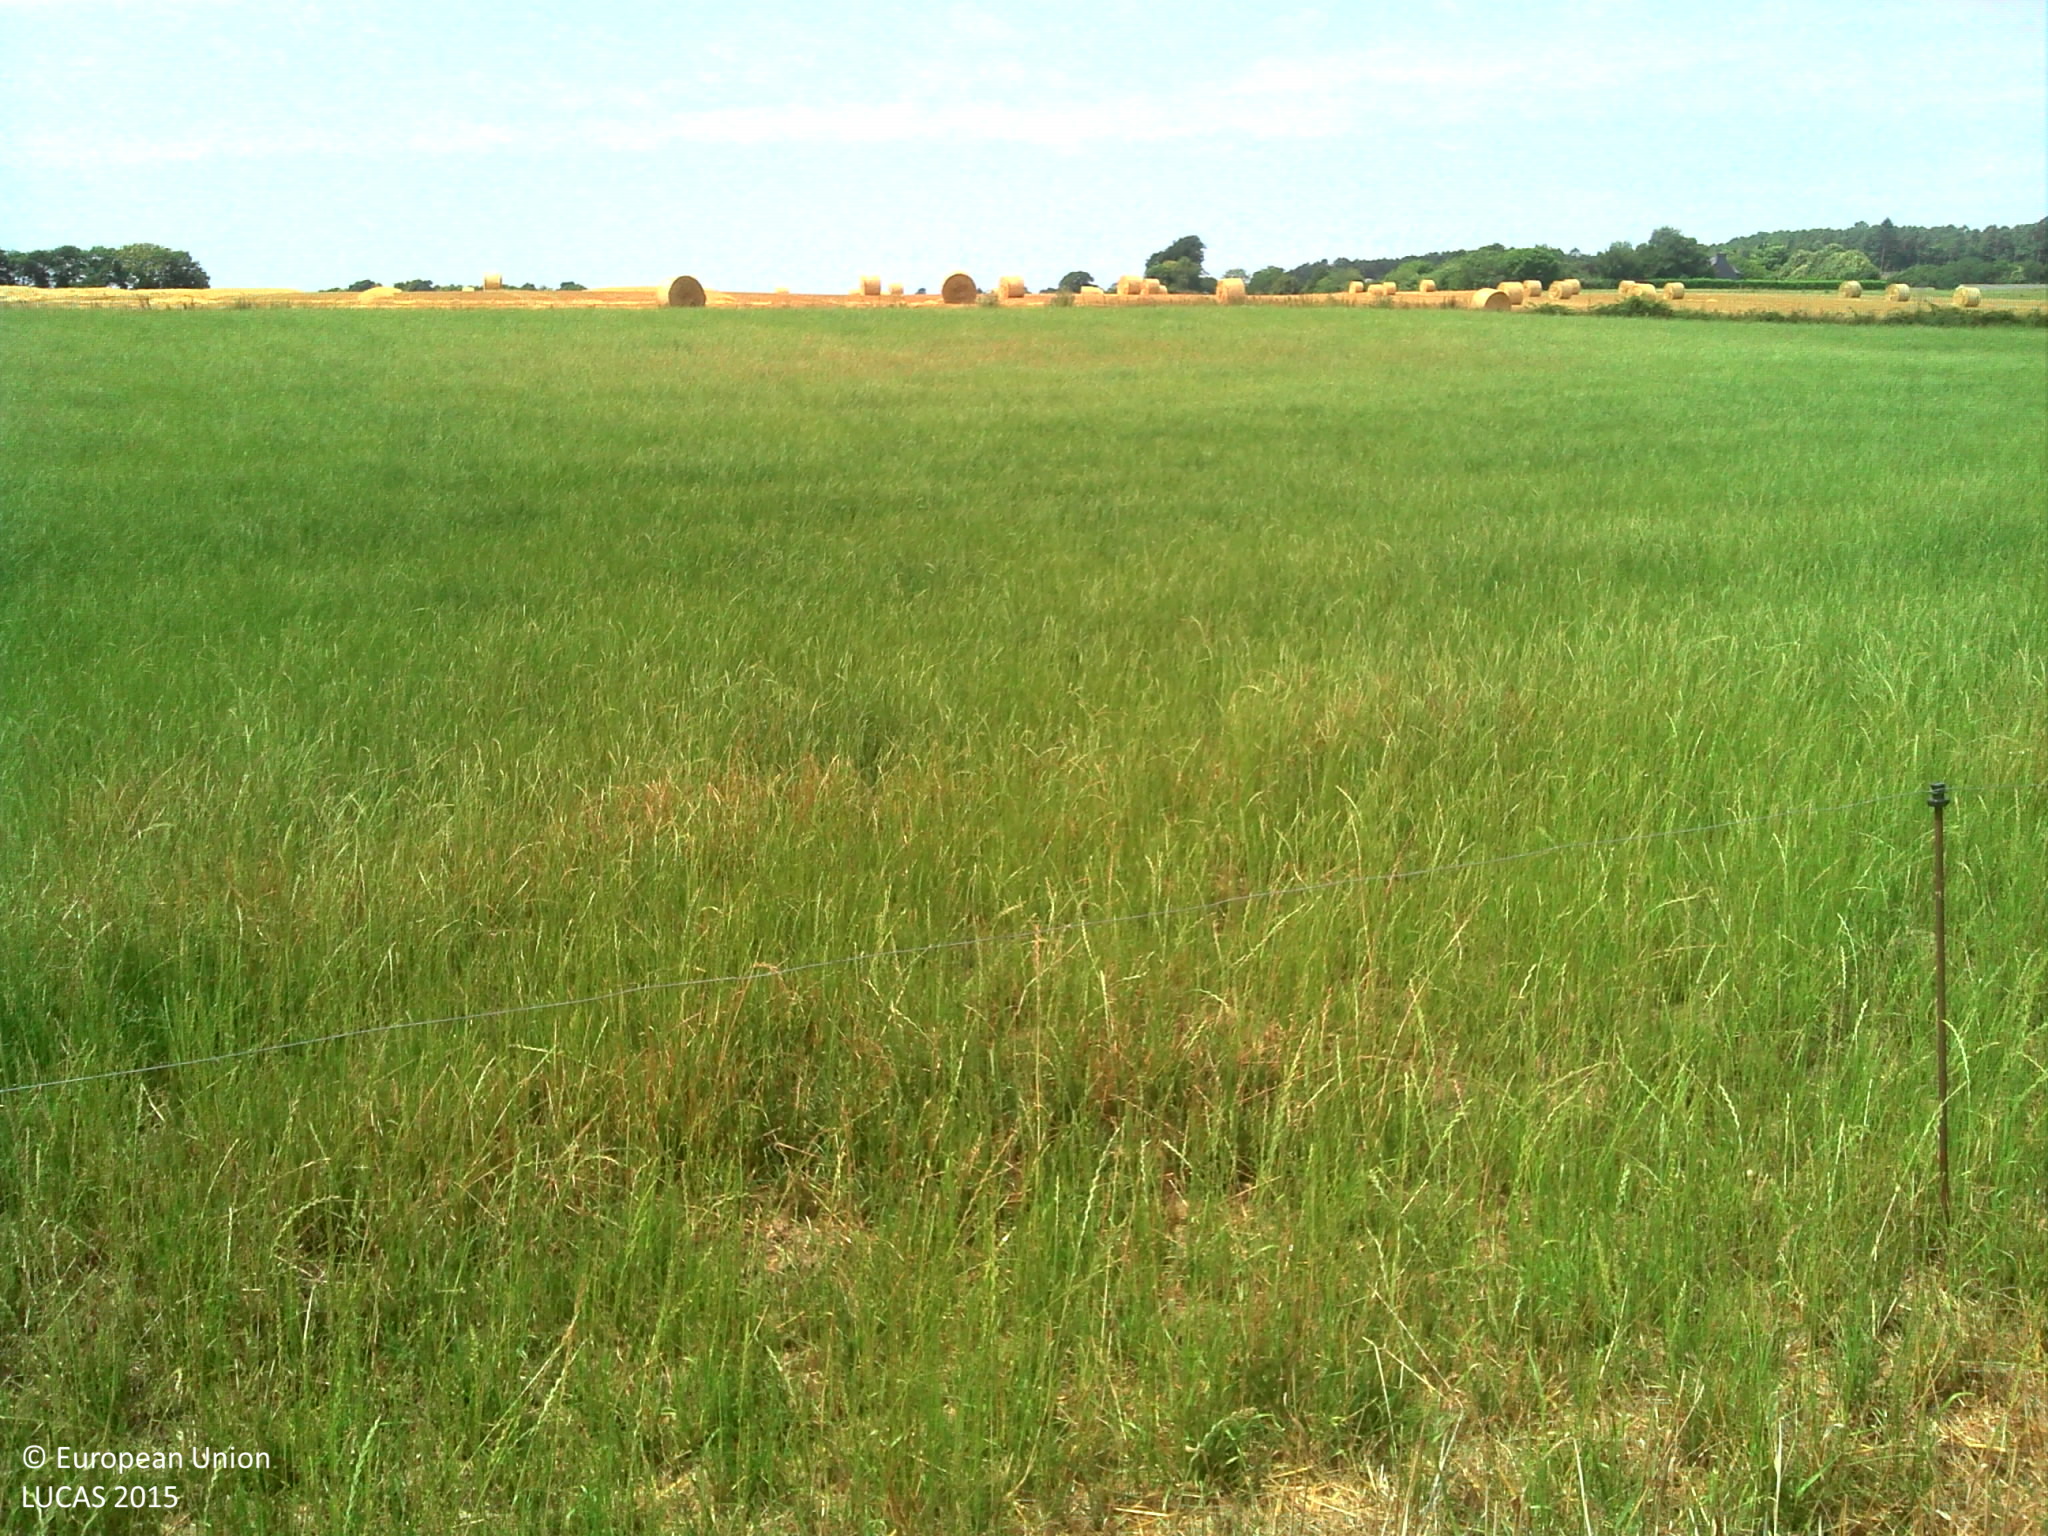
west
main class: Cropland
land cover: Barley
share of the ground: > 75 %
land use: Agriculture (excluding fallow land and kitchen gardens)
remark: Harvested field
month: July
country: FR
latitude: 47.9052
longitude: -3.3035
